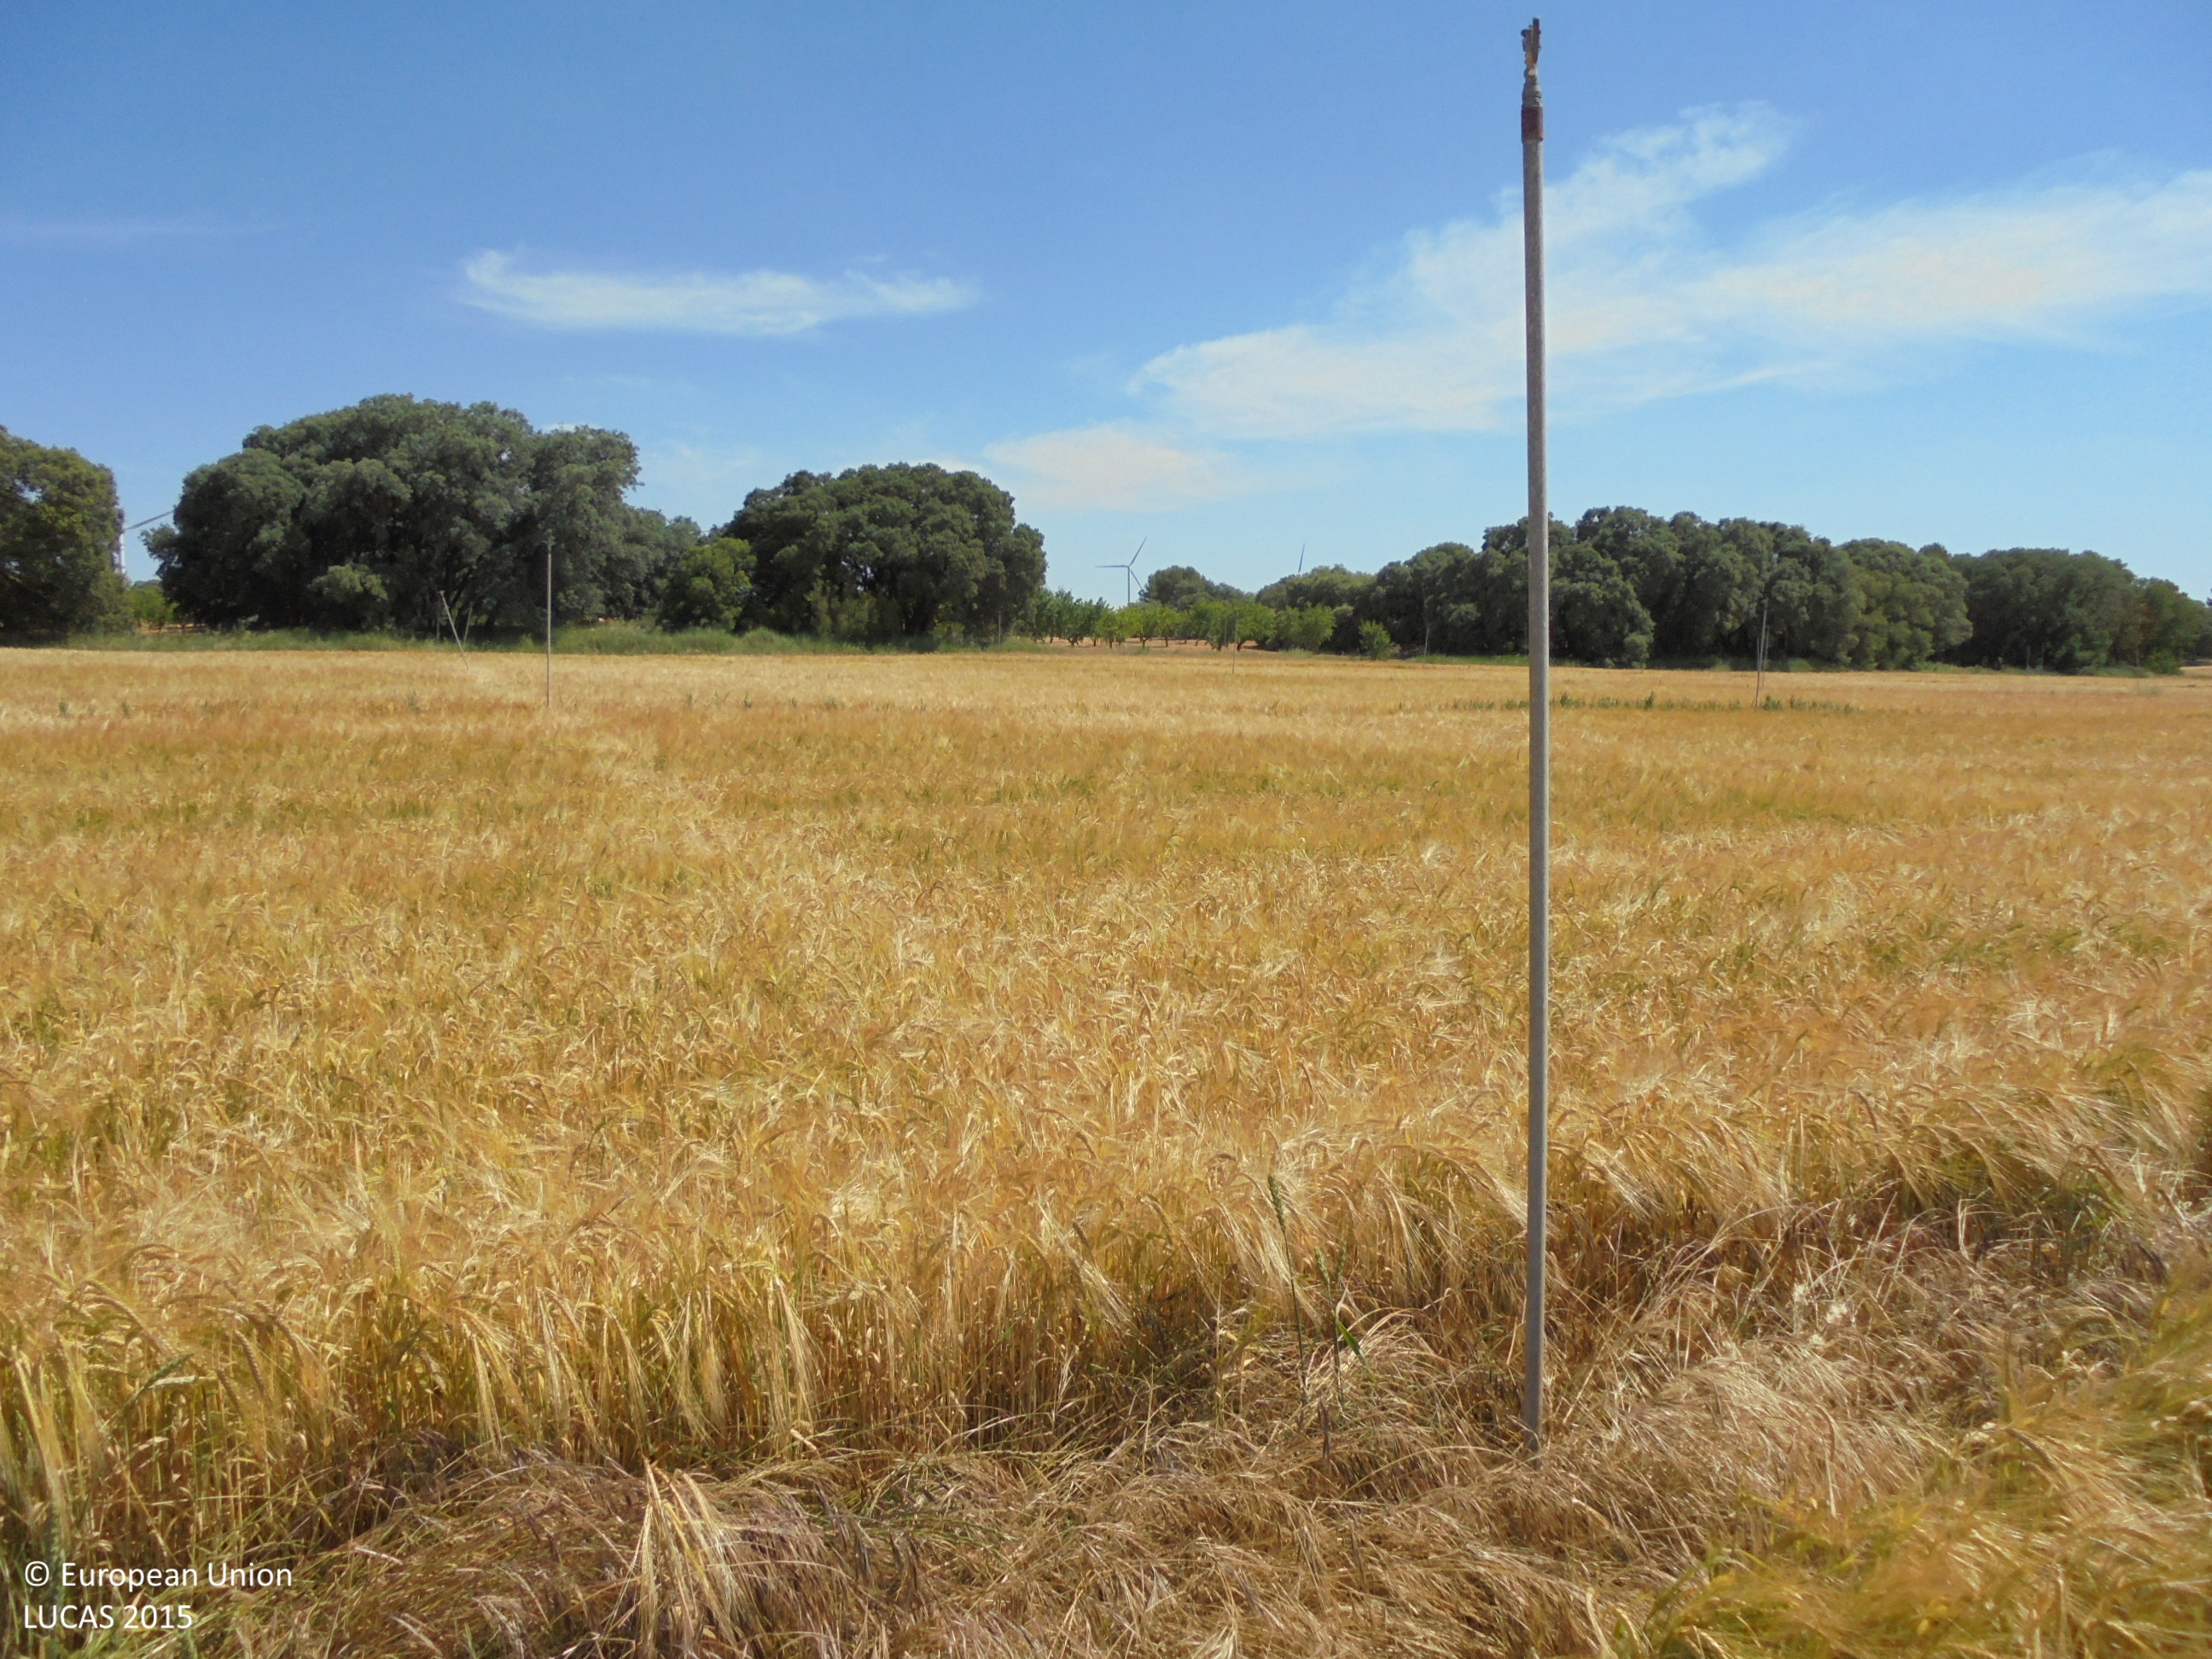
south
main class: Cropland
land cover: Barley
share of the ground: > 75 %
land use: Agriculture (excluding fallow land and kitchen gardens)
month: June
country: ES
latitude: 38.7593
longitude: -1.5609
